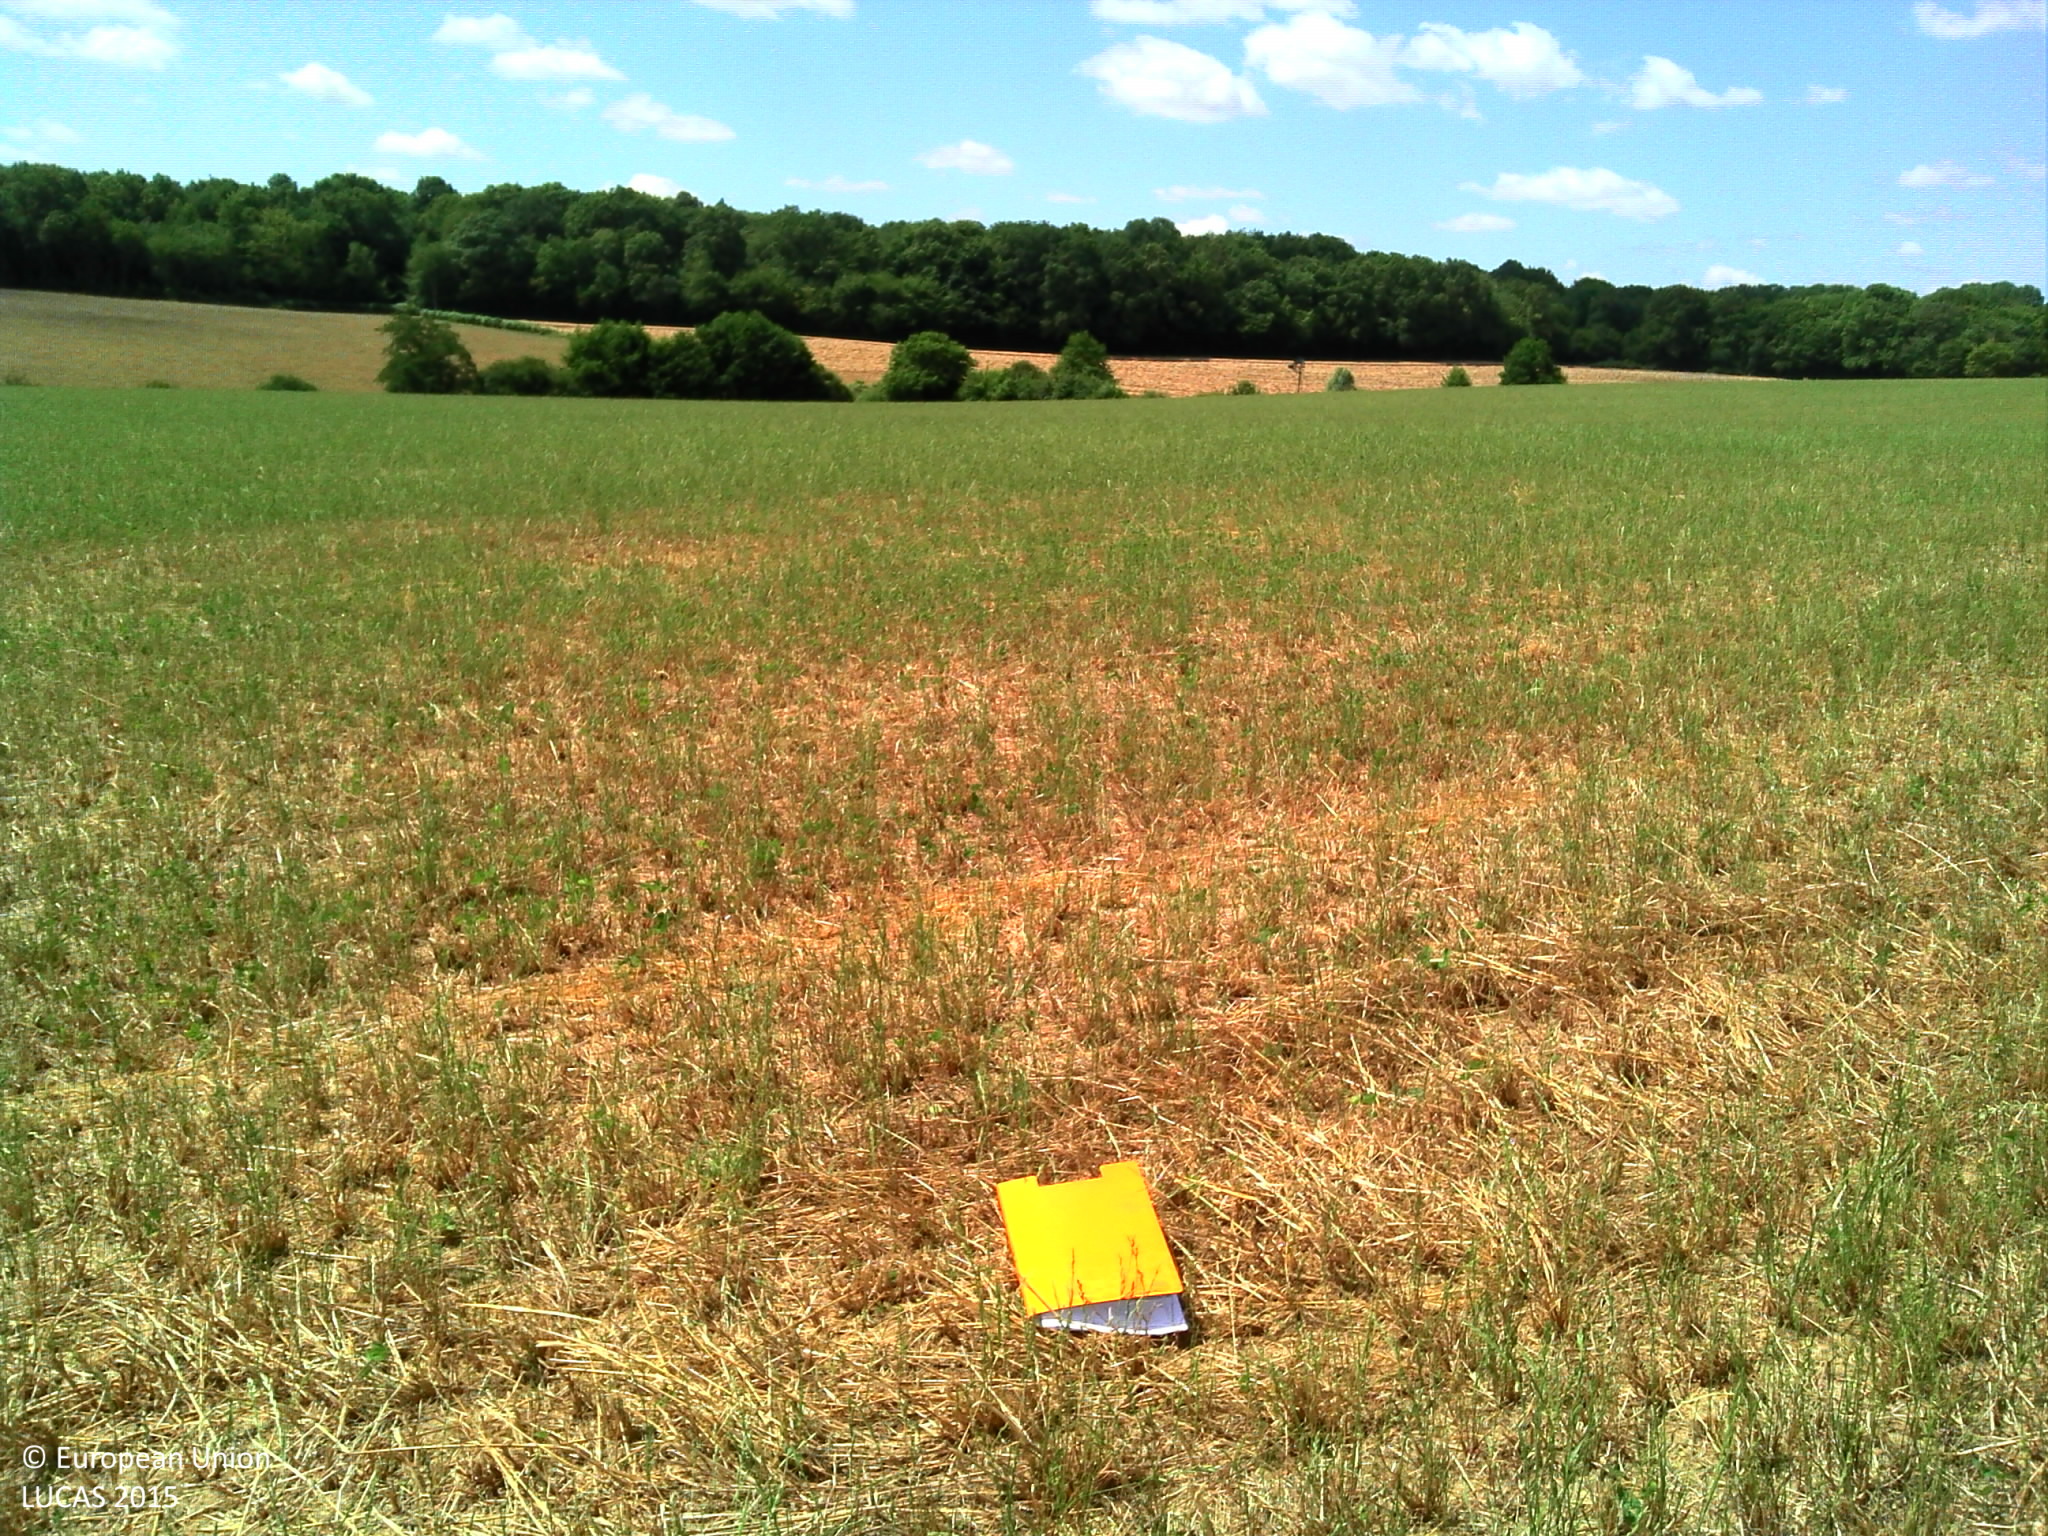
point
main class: Cropland
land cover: Mixed cereals for fodder
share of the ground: > 75 %
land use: Agriculture (excluding fallow land and kitchen gardens)
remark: Harvested field
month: July
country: FR
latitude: 46.9019
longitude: 3.6315
